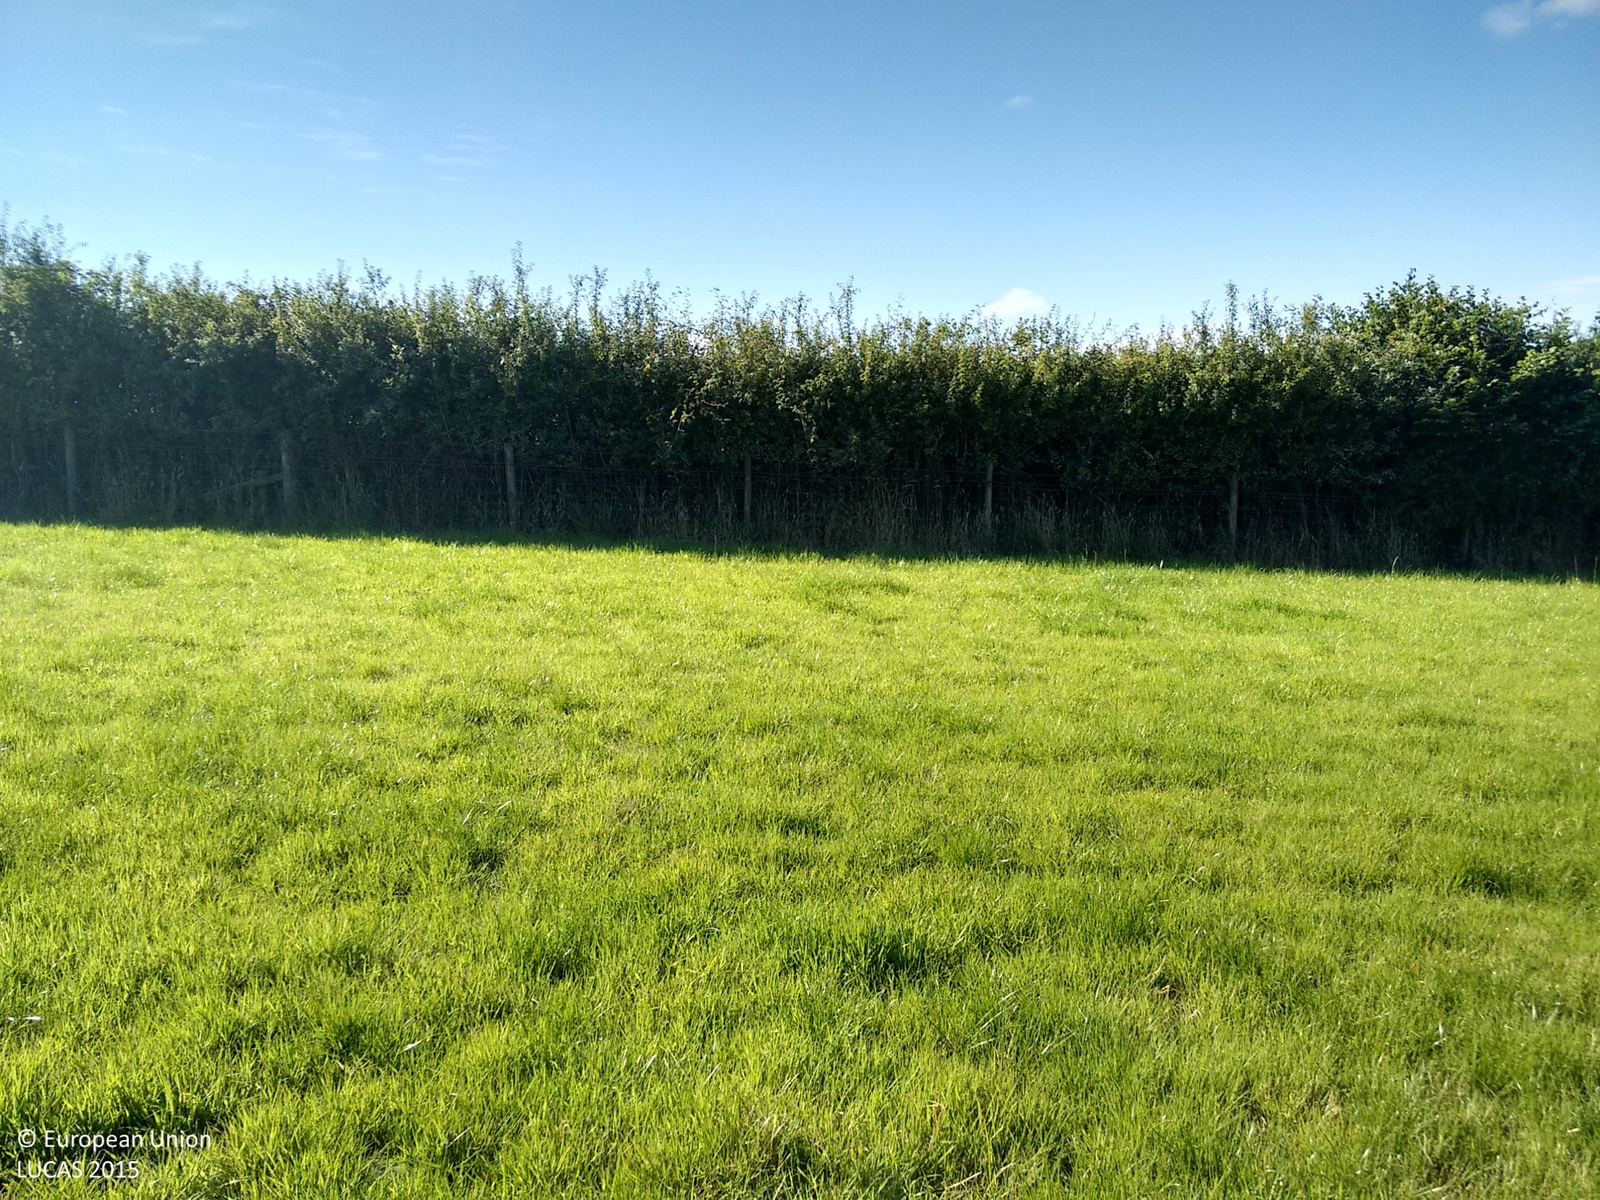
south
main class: Grassland
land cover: Grassland without tree/shrub cover
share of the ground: > 75 %
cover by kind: herbaceous plants 100 %
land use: Agriculture (excluding fallow land and kitchen gardens)
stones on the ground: < 10 %
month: August
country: GB
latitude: 50.8595
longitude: -3.4517
